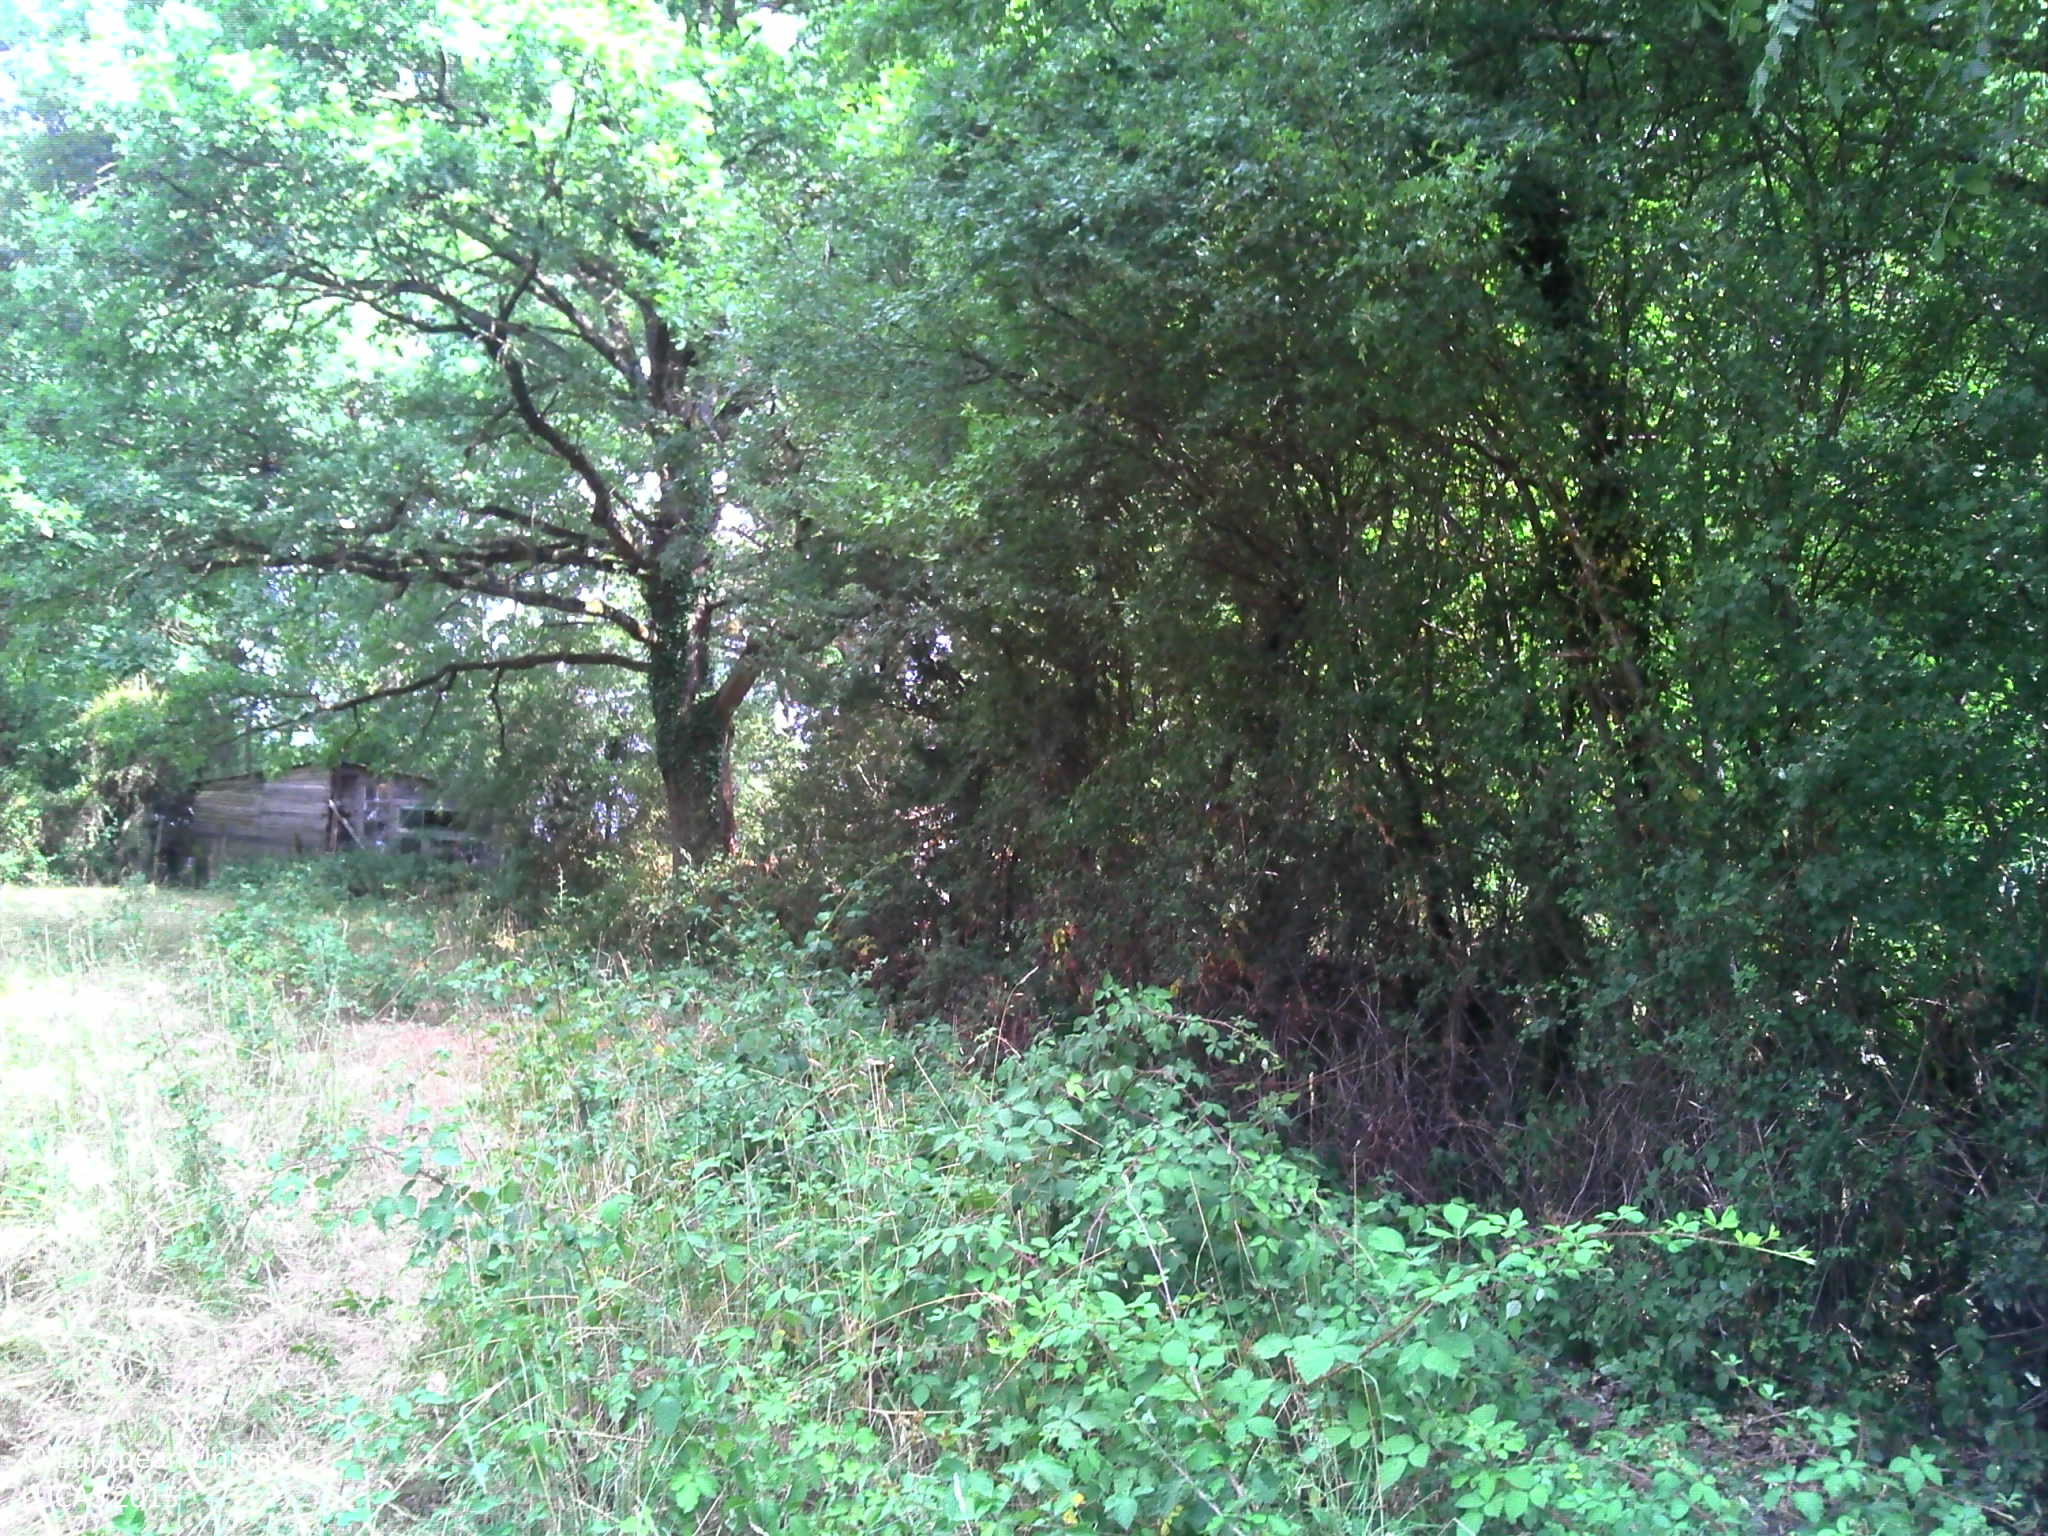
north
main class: Grassland
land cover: Grassland with sparse tree/shrub cover
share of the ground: > 75 %
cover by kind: herbaceous plants 85 %, shrubs 10 %, broadleaved forest trees 5 %
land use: Agriculture (excluding fallow land and kitchen gardens)
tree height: > 5 m
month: July
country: FR
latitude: 46.6301
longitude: 3.0351
